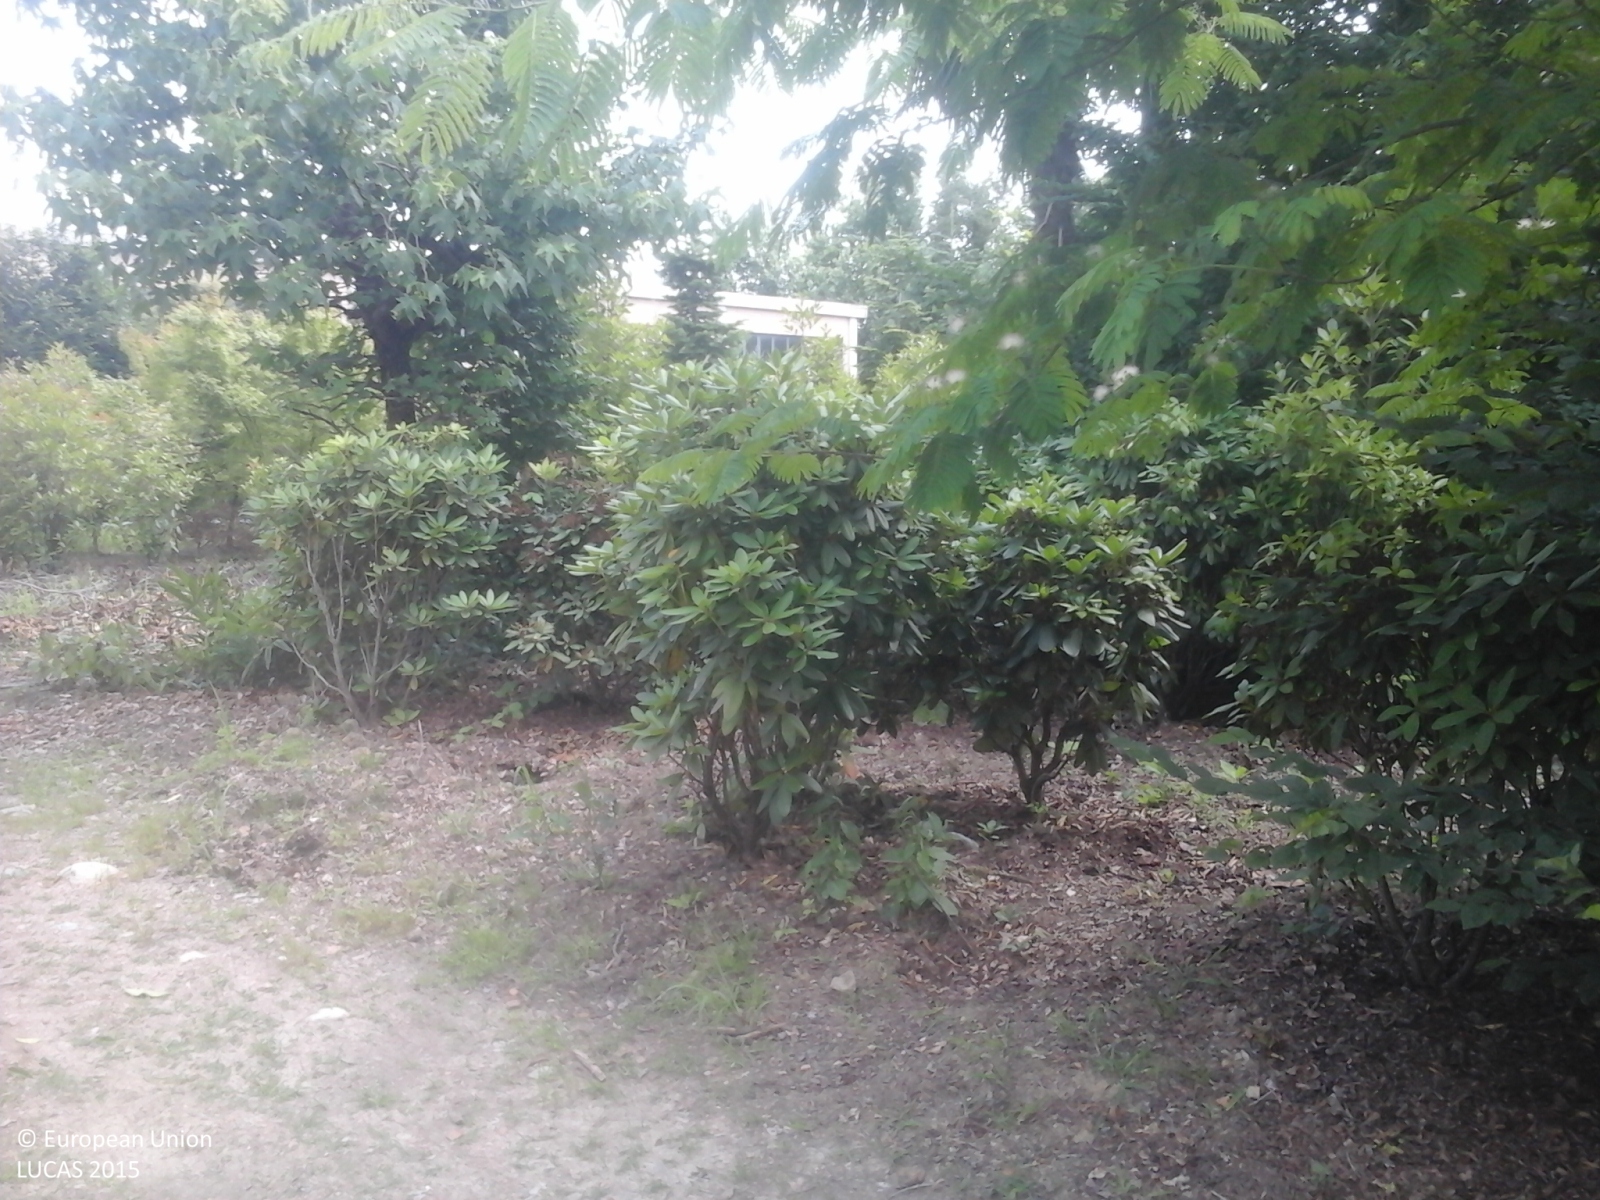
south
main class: Cropland
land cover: Nurseries
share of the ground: > 75 %
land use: Agriculture (excluding fallow land and kitchen gardens)
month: June
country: IT
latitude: 45.7189
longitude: 9.3971
